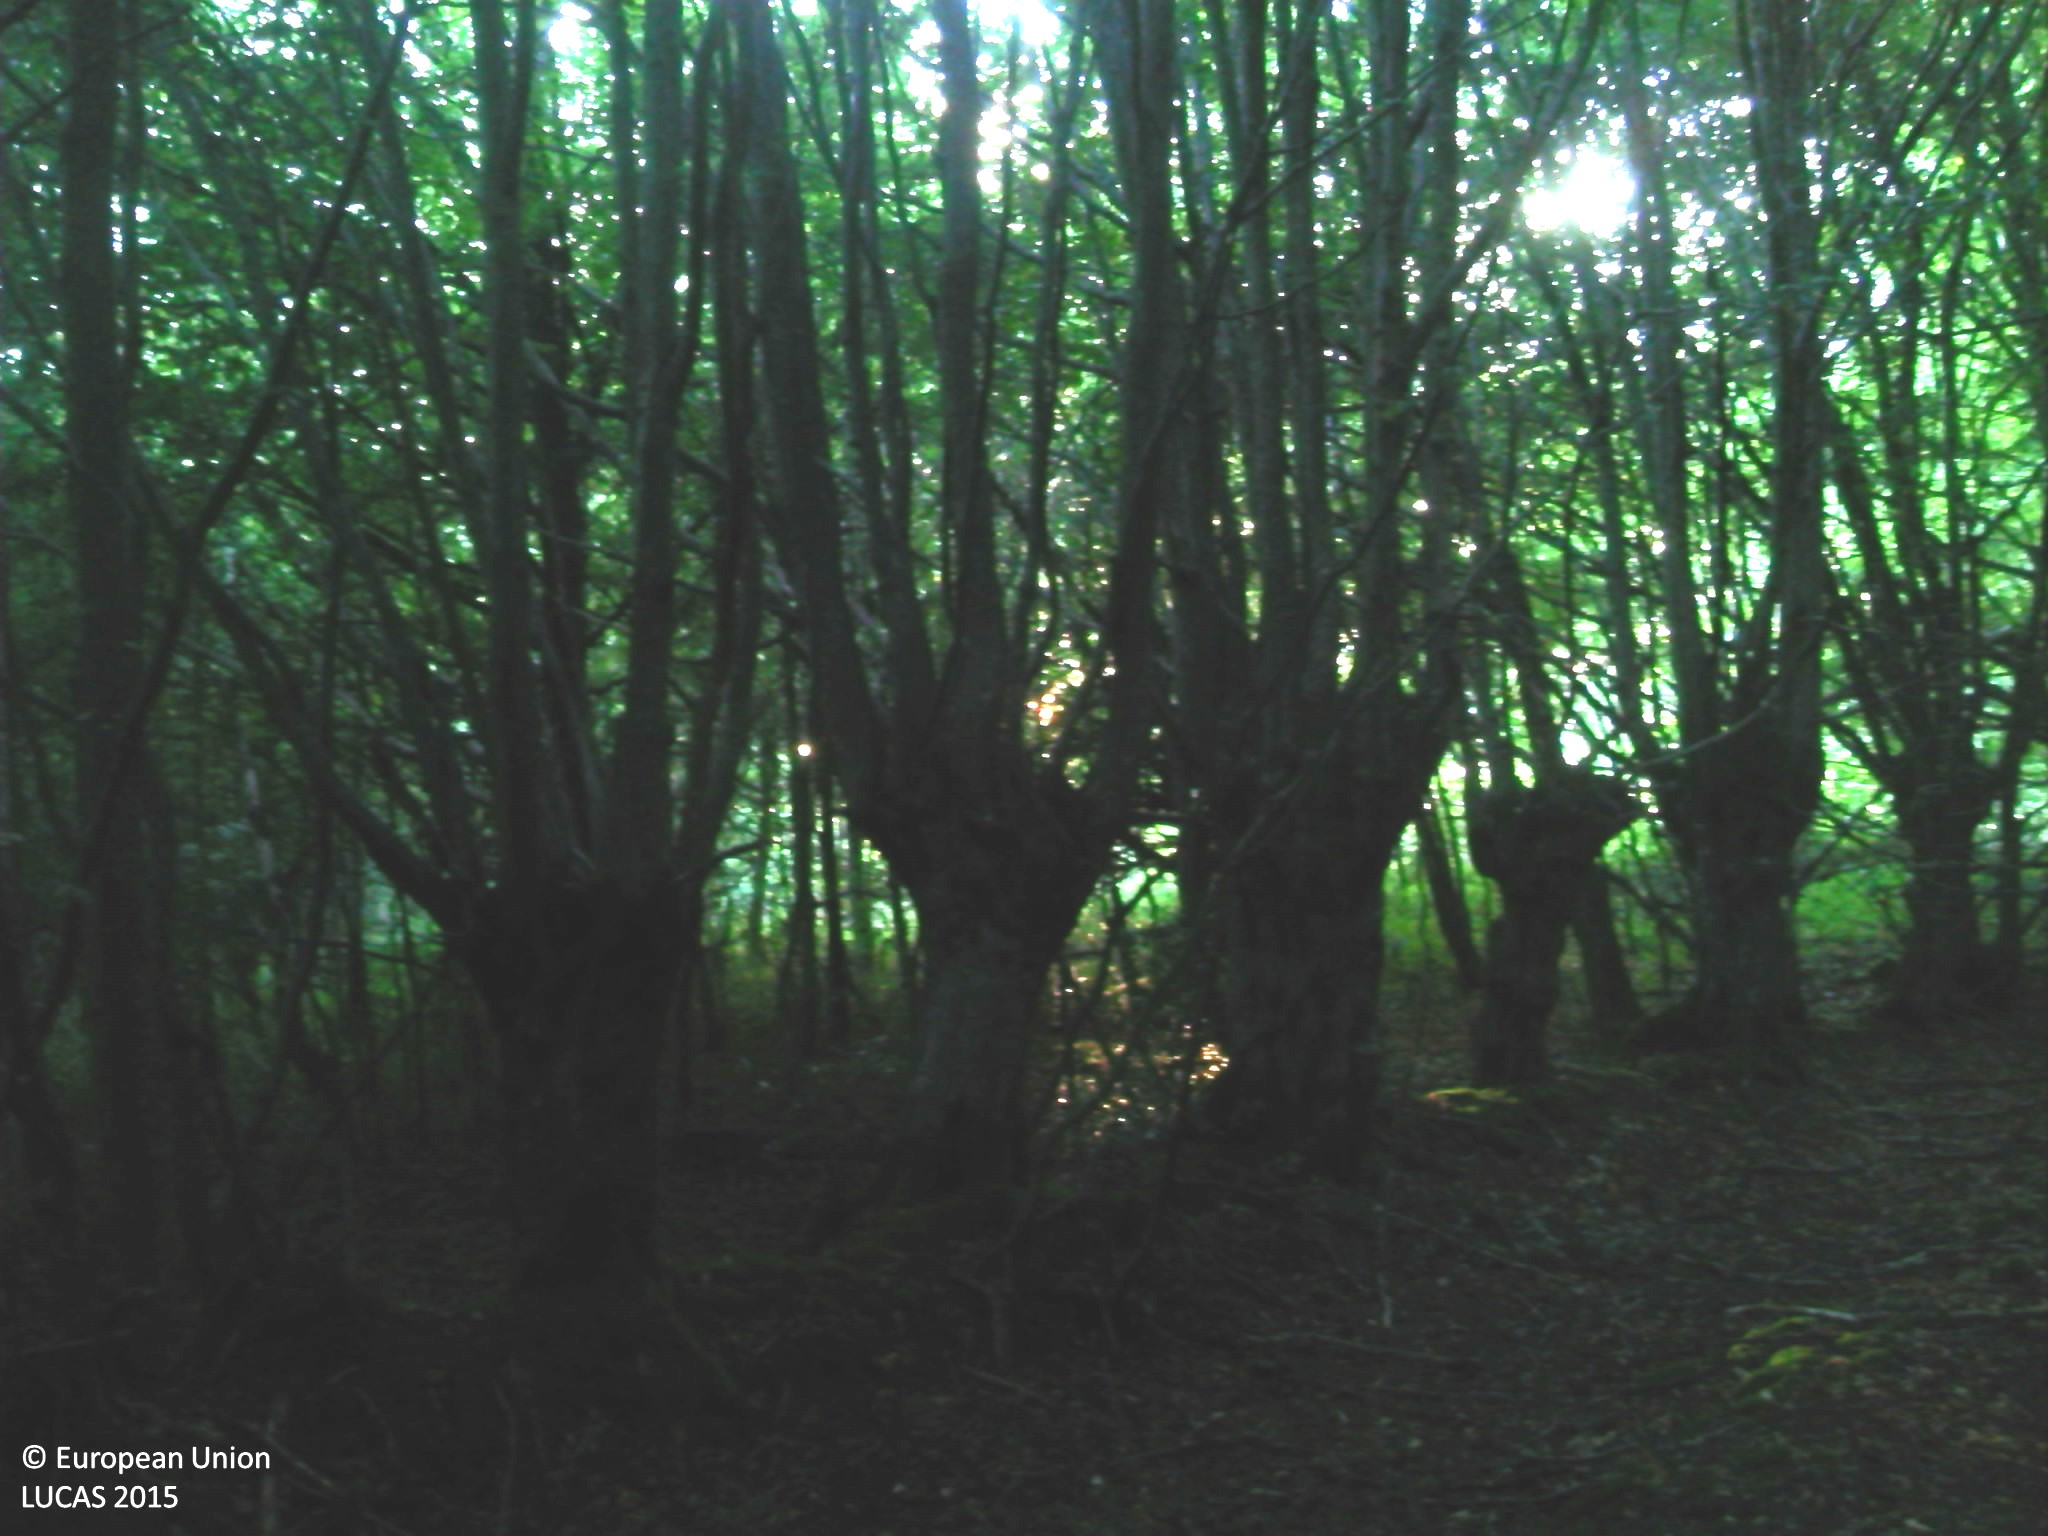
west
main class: Woodland
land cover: Spruce dominated mixed woodland
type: mesophytic deciduous forest
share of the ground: > 75 %
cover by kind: coniferous forest trees 45 %, broadleaved forest trees 25 %, shrubs 10 %, herbaceous plants 10 %, lichens and mosses 10 %
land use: Forestry
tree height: > 5 m
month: September
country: FR
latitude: 48.4714
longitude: 0.7936
